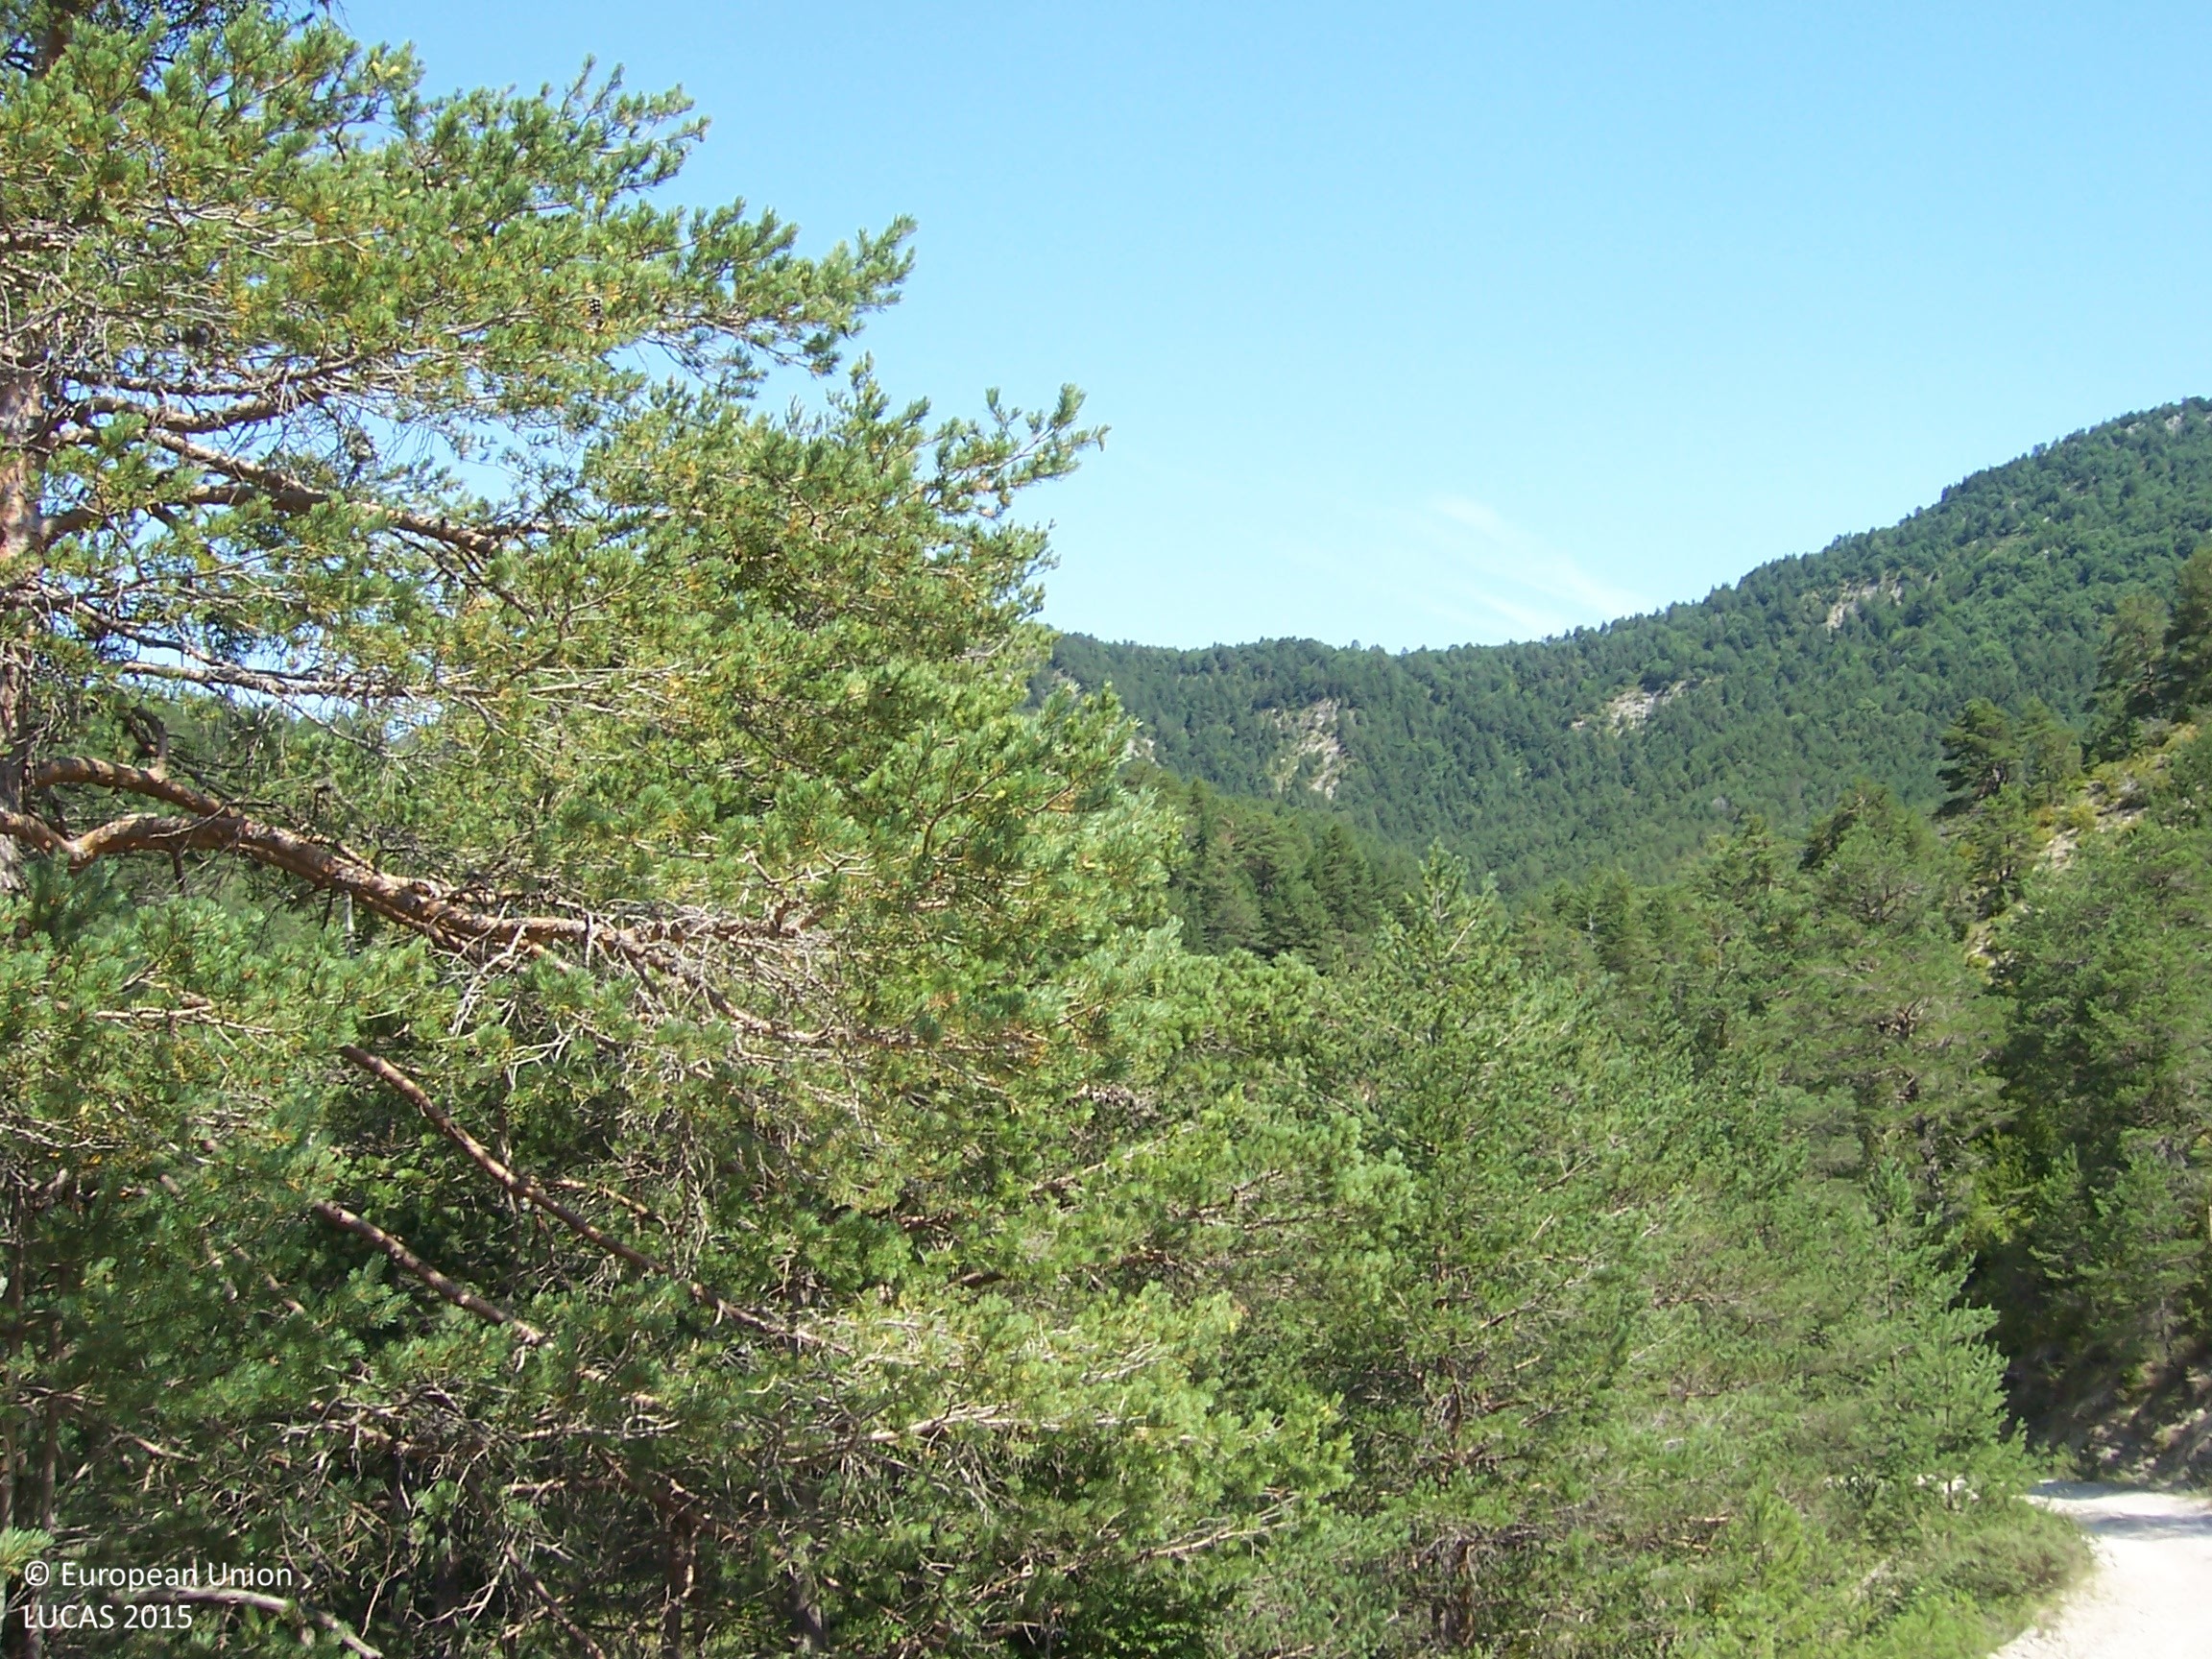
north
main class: Woodland
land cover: Pine dominated coniferous woodland
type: coniferous forest of the mediterranean region
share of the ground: > 75 %
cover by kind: coniferous forest trees 100 %
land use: Forestry
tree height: > 5 m
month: July
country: ES
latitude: 42.8317
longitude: -1.2040
